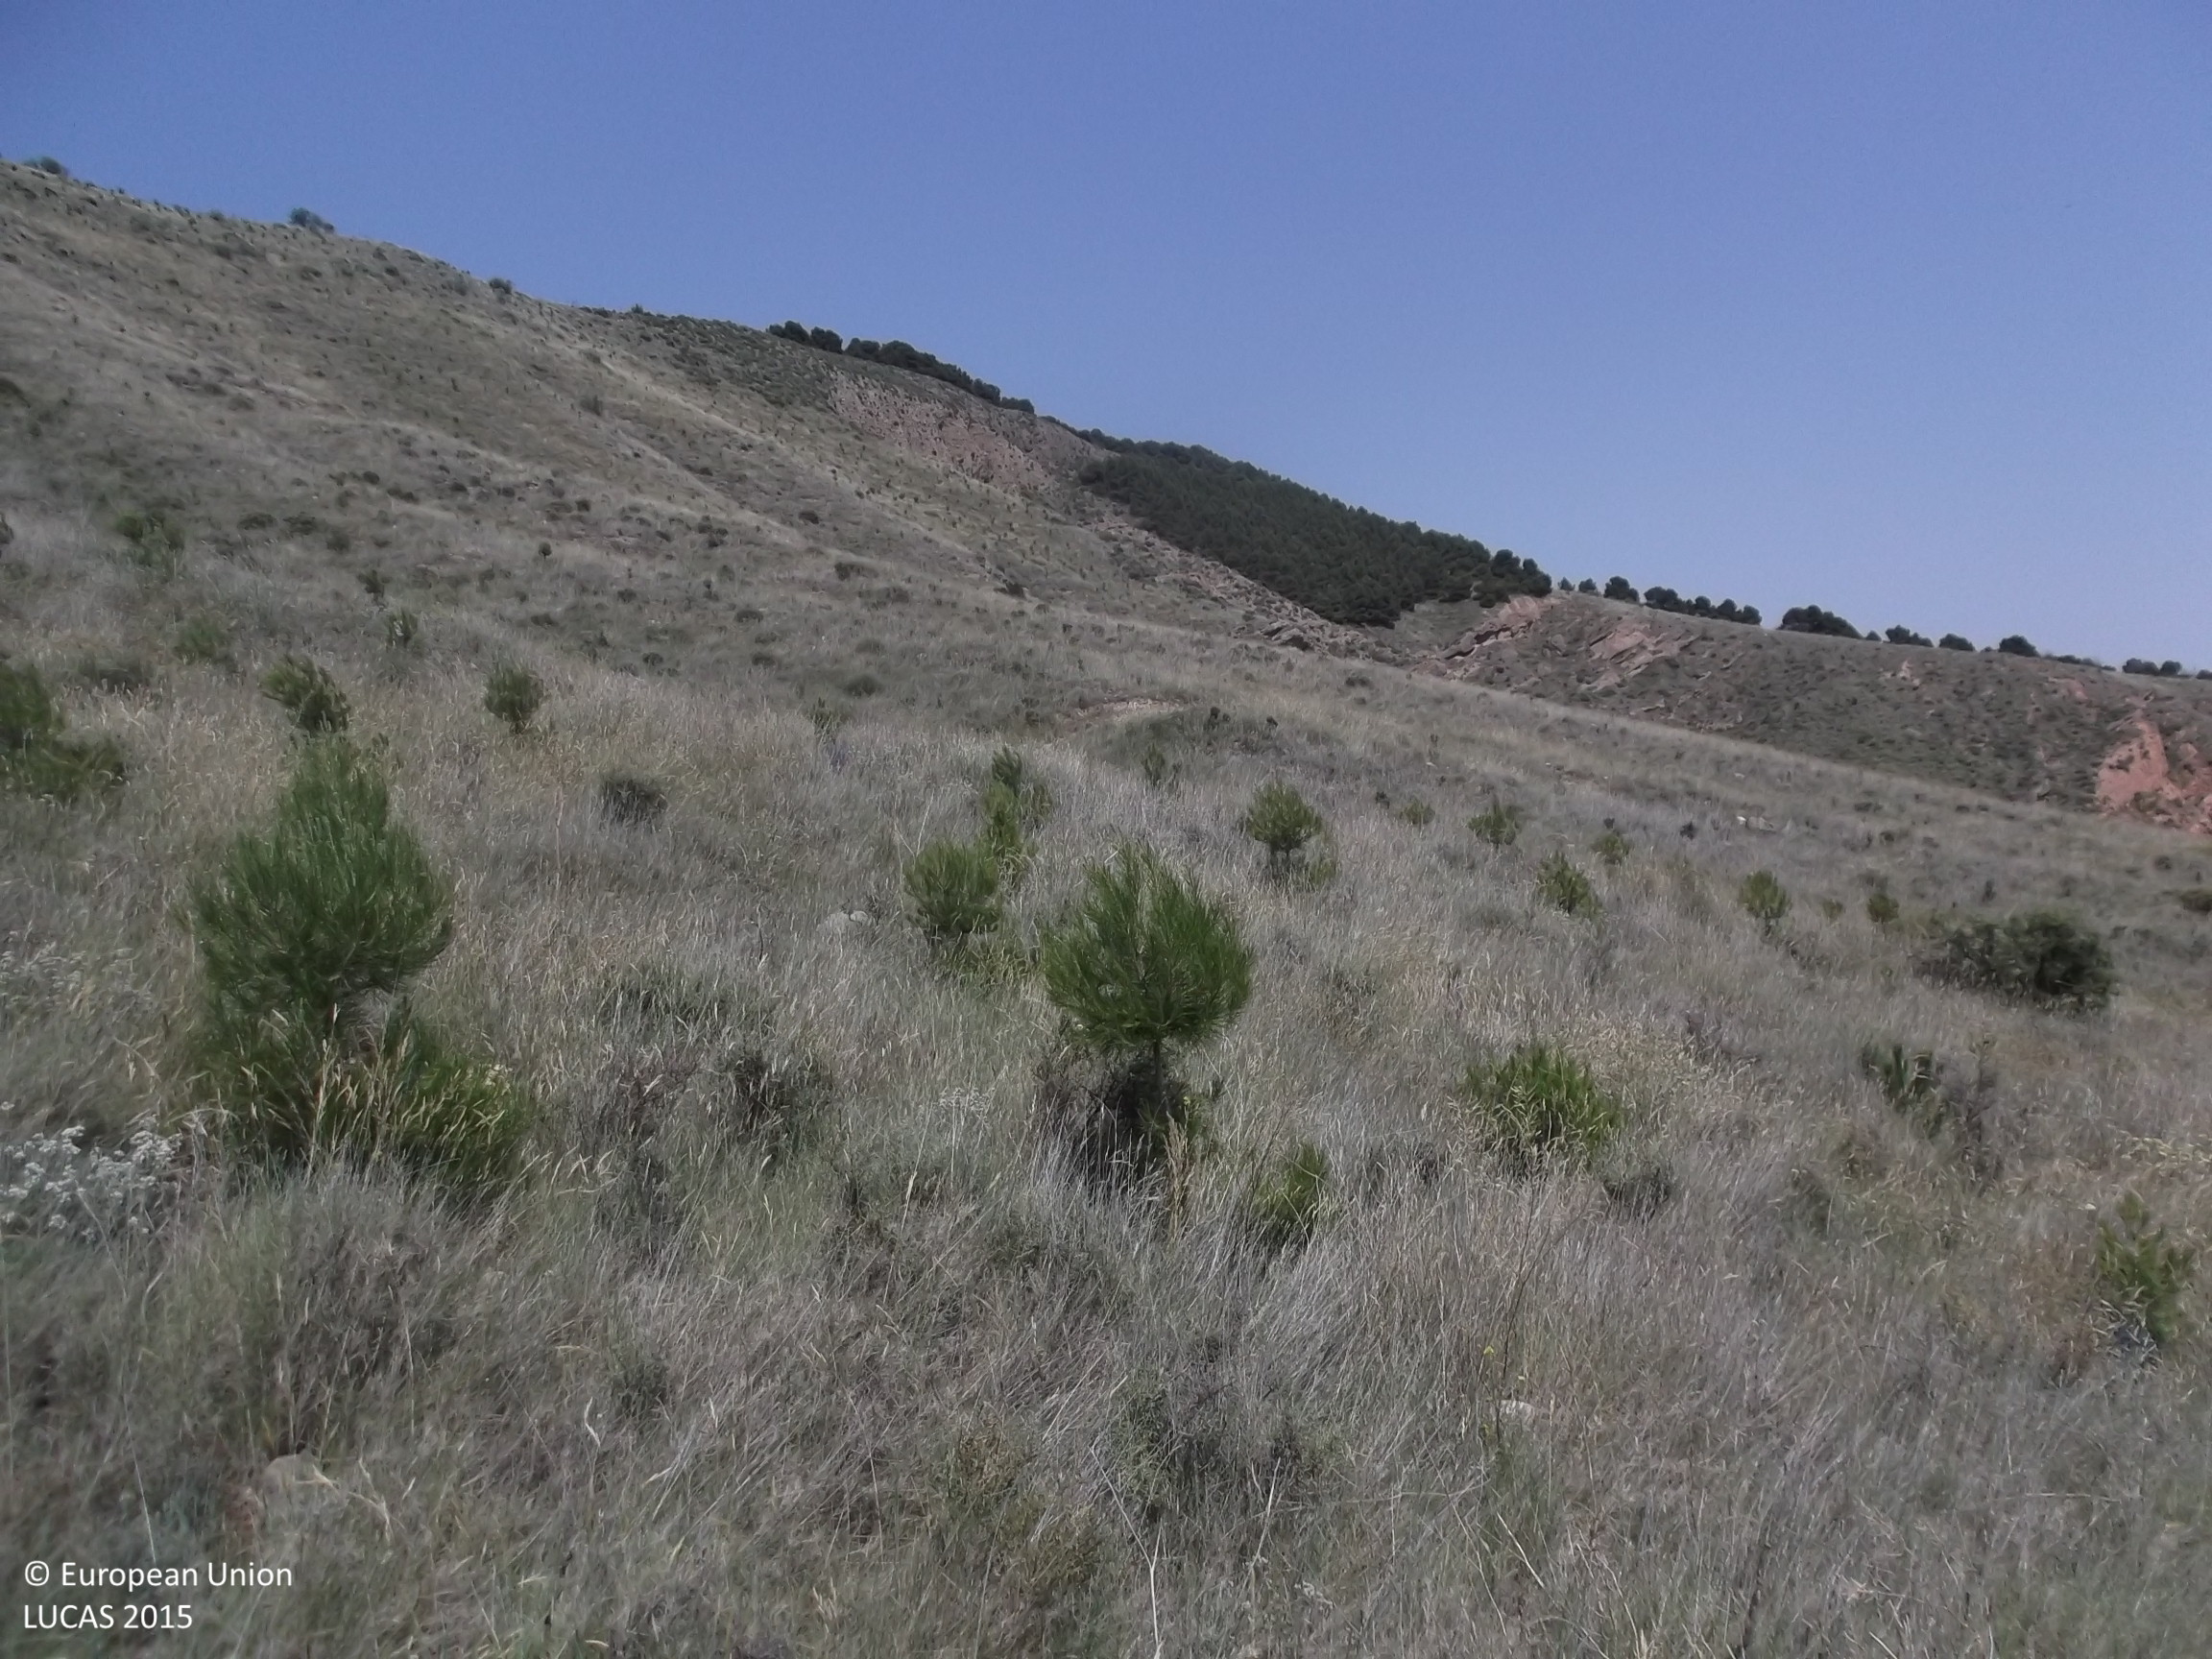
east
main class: Woodland
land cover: Pine dominated coniferous woodland
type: coniferous forest of the mediterranean region
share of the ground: 10 - 25 %
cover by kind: shrubs 70 %, coniferous forest trees 10 %, herbaceous plants 10 %, unconsolidated bare surface 10 %
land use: Forestry
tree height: < 5 m
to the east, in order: Pine dominated coniferous woodland; Shrubland without tree cover
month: June
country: ES
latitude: 42.2393
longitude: -2.0718
